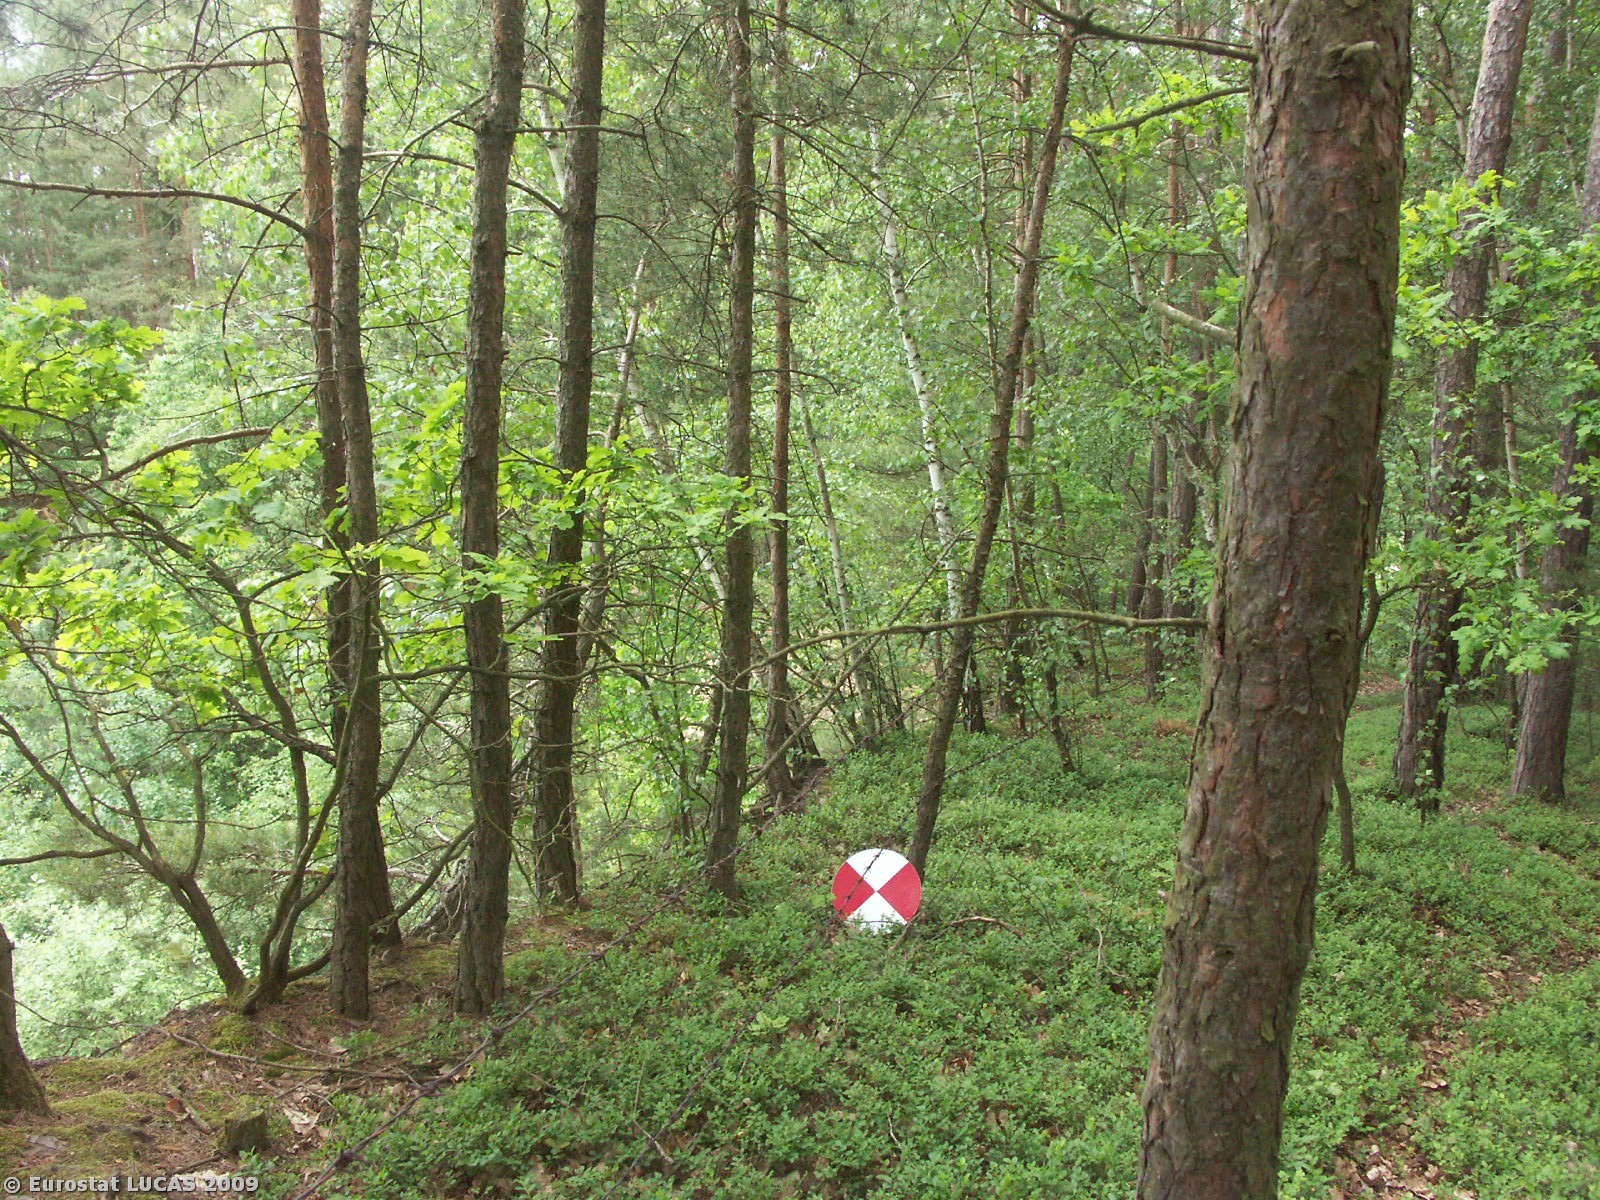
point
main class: Woodland
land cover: Mixed woodland
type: hemiboreal forest and nemoral coniferous forest and mixed broadleaved-coniferous forest
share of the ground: > 75 %
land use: Forestry
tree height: > 5 m
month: May
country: CZ
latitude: 48.8453
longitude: 14.6753
